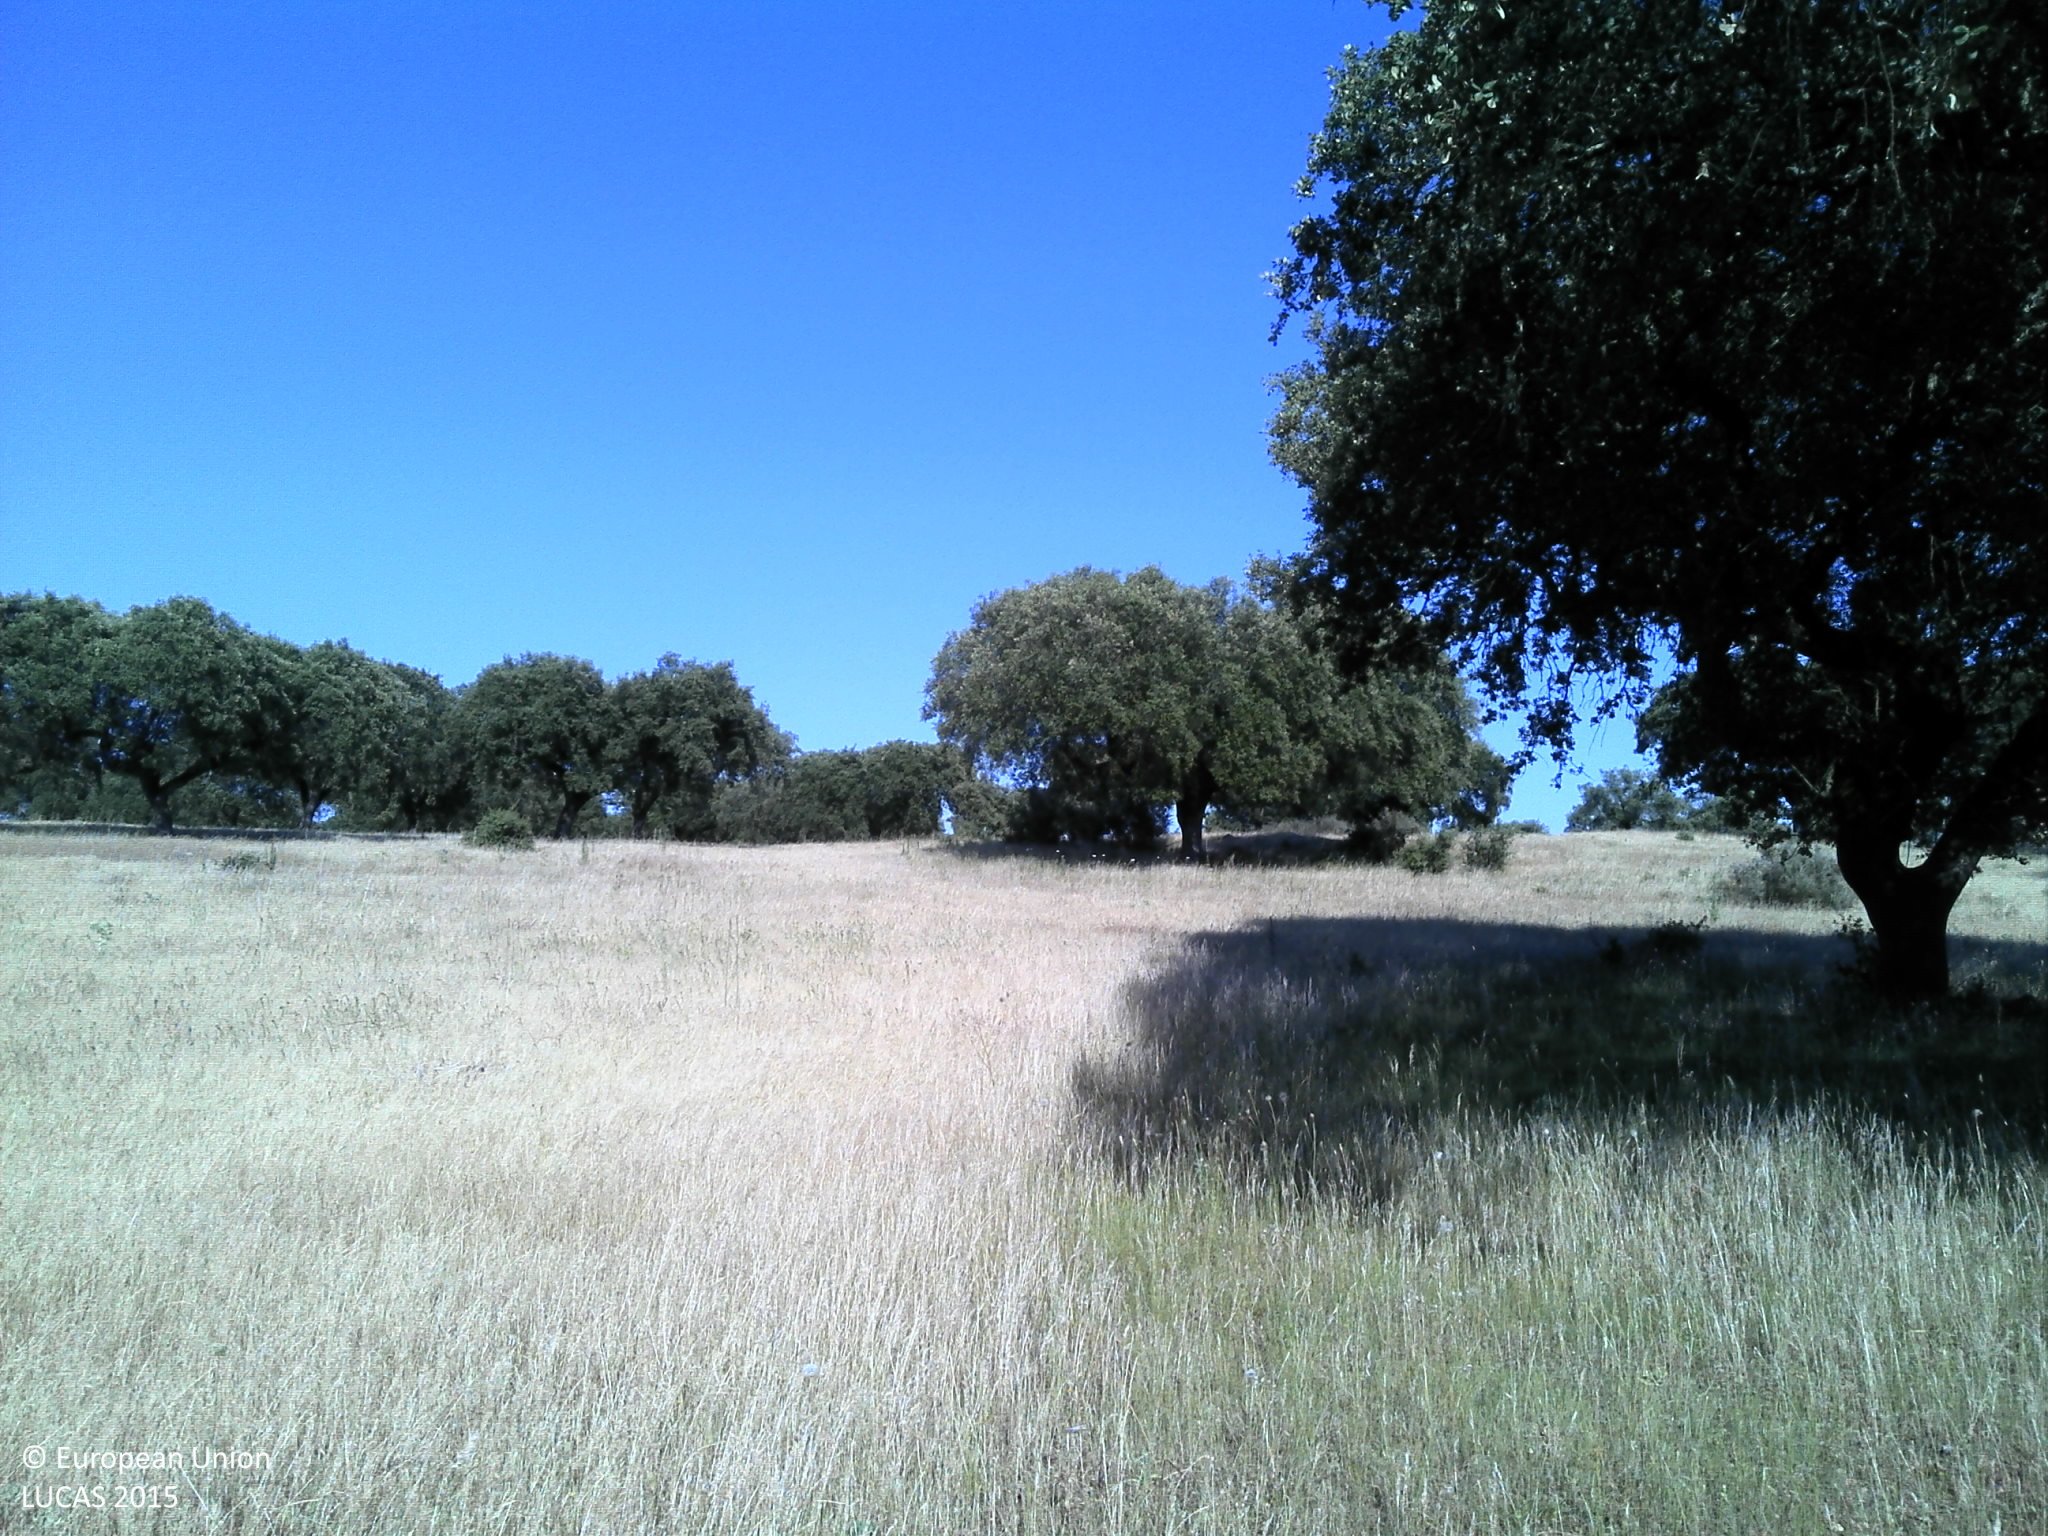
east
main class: Woodland
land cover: Broadleaved woodland
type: broadleaved evergreen forest
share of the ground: 25 - 50 %
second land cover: Grassland without tree/shrub cover
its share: 50 - 75 %
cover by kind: herbaceous plants 60 %, broadleaved forest trees 30 %, unconsolidated bare surface 10 %
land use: Forestry
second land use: Agriculture (excluding fallow land and kitchen gardens)
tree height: > 5 m
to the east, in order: Broadleaved woodland; Grassland without tree/shrub cover; Broadleaved woodland
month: June
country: PT
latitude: 38.7306
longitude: -8.1193
